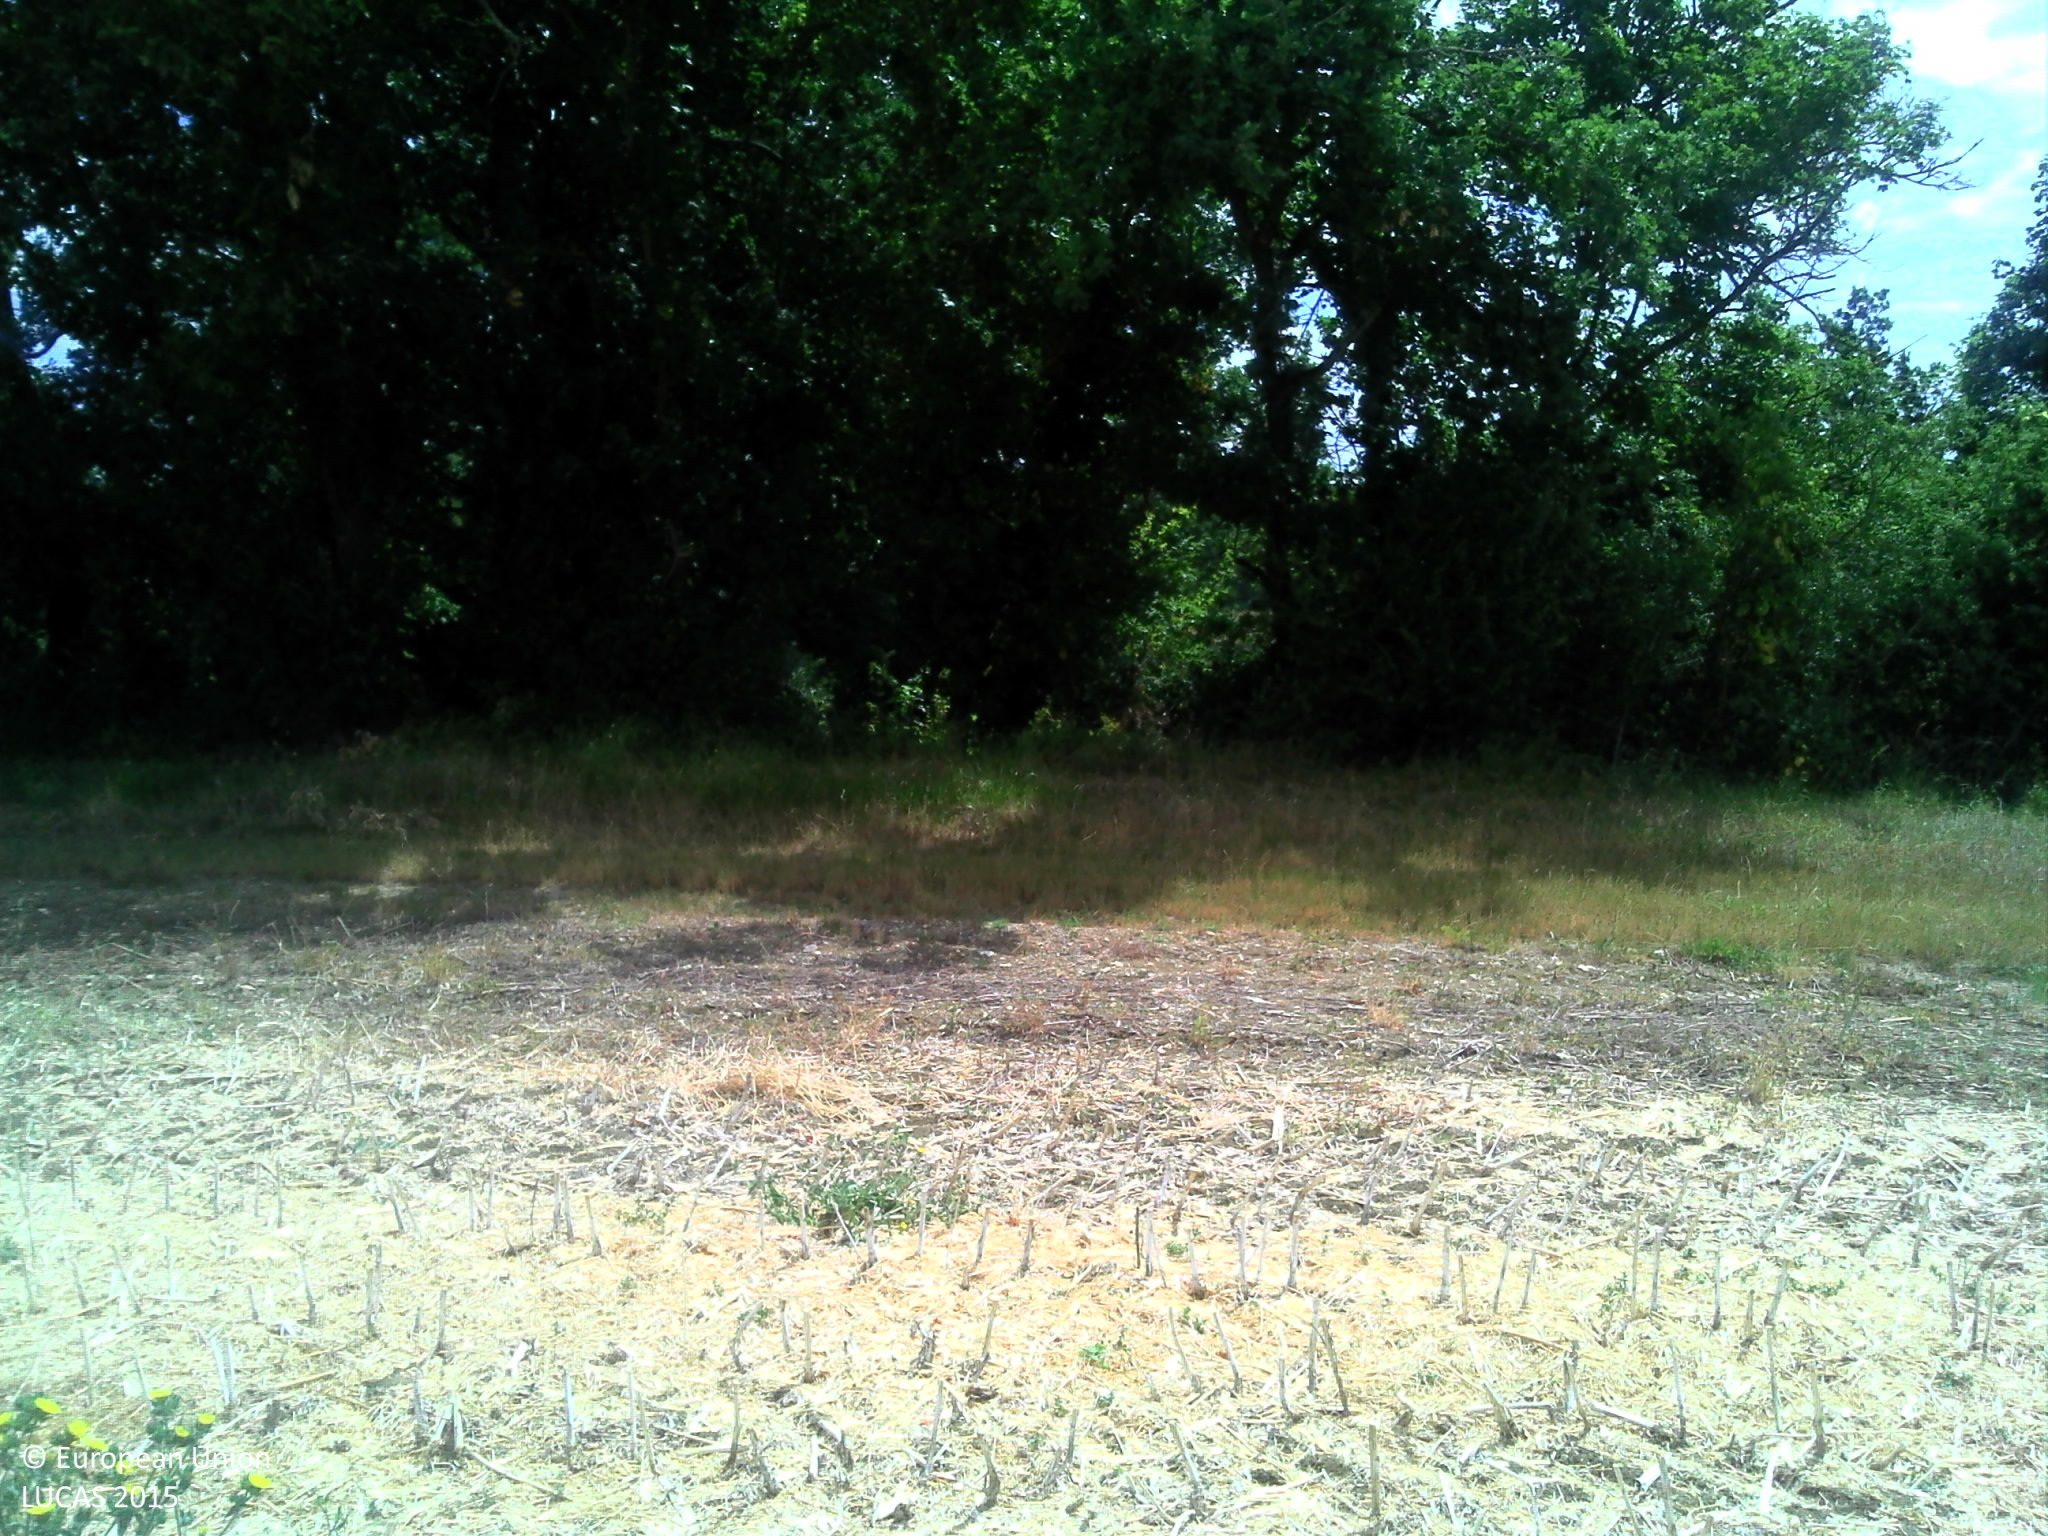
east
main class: Cropland
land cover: Rape and turnip rape
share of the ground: > 75 %
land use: Agriculture (excluding fallow land and kitchen gardens)
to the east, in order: Rape and turnip rape; Grassland without tree/shrub cover; Broadleaved woodland; Rock outcrops; Broadleaved woodland; Grassland without tree/shrub cover; Common wheat
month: July
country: FR
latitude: 43.9157
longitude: 0.7192
